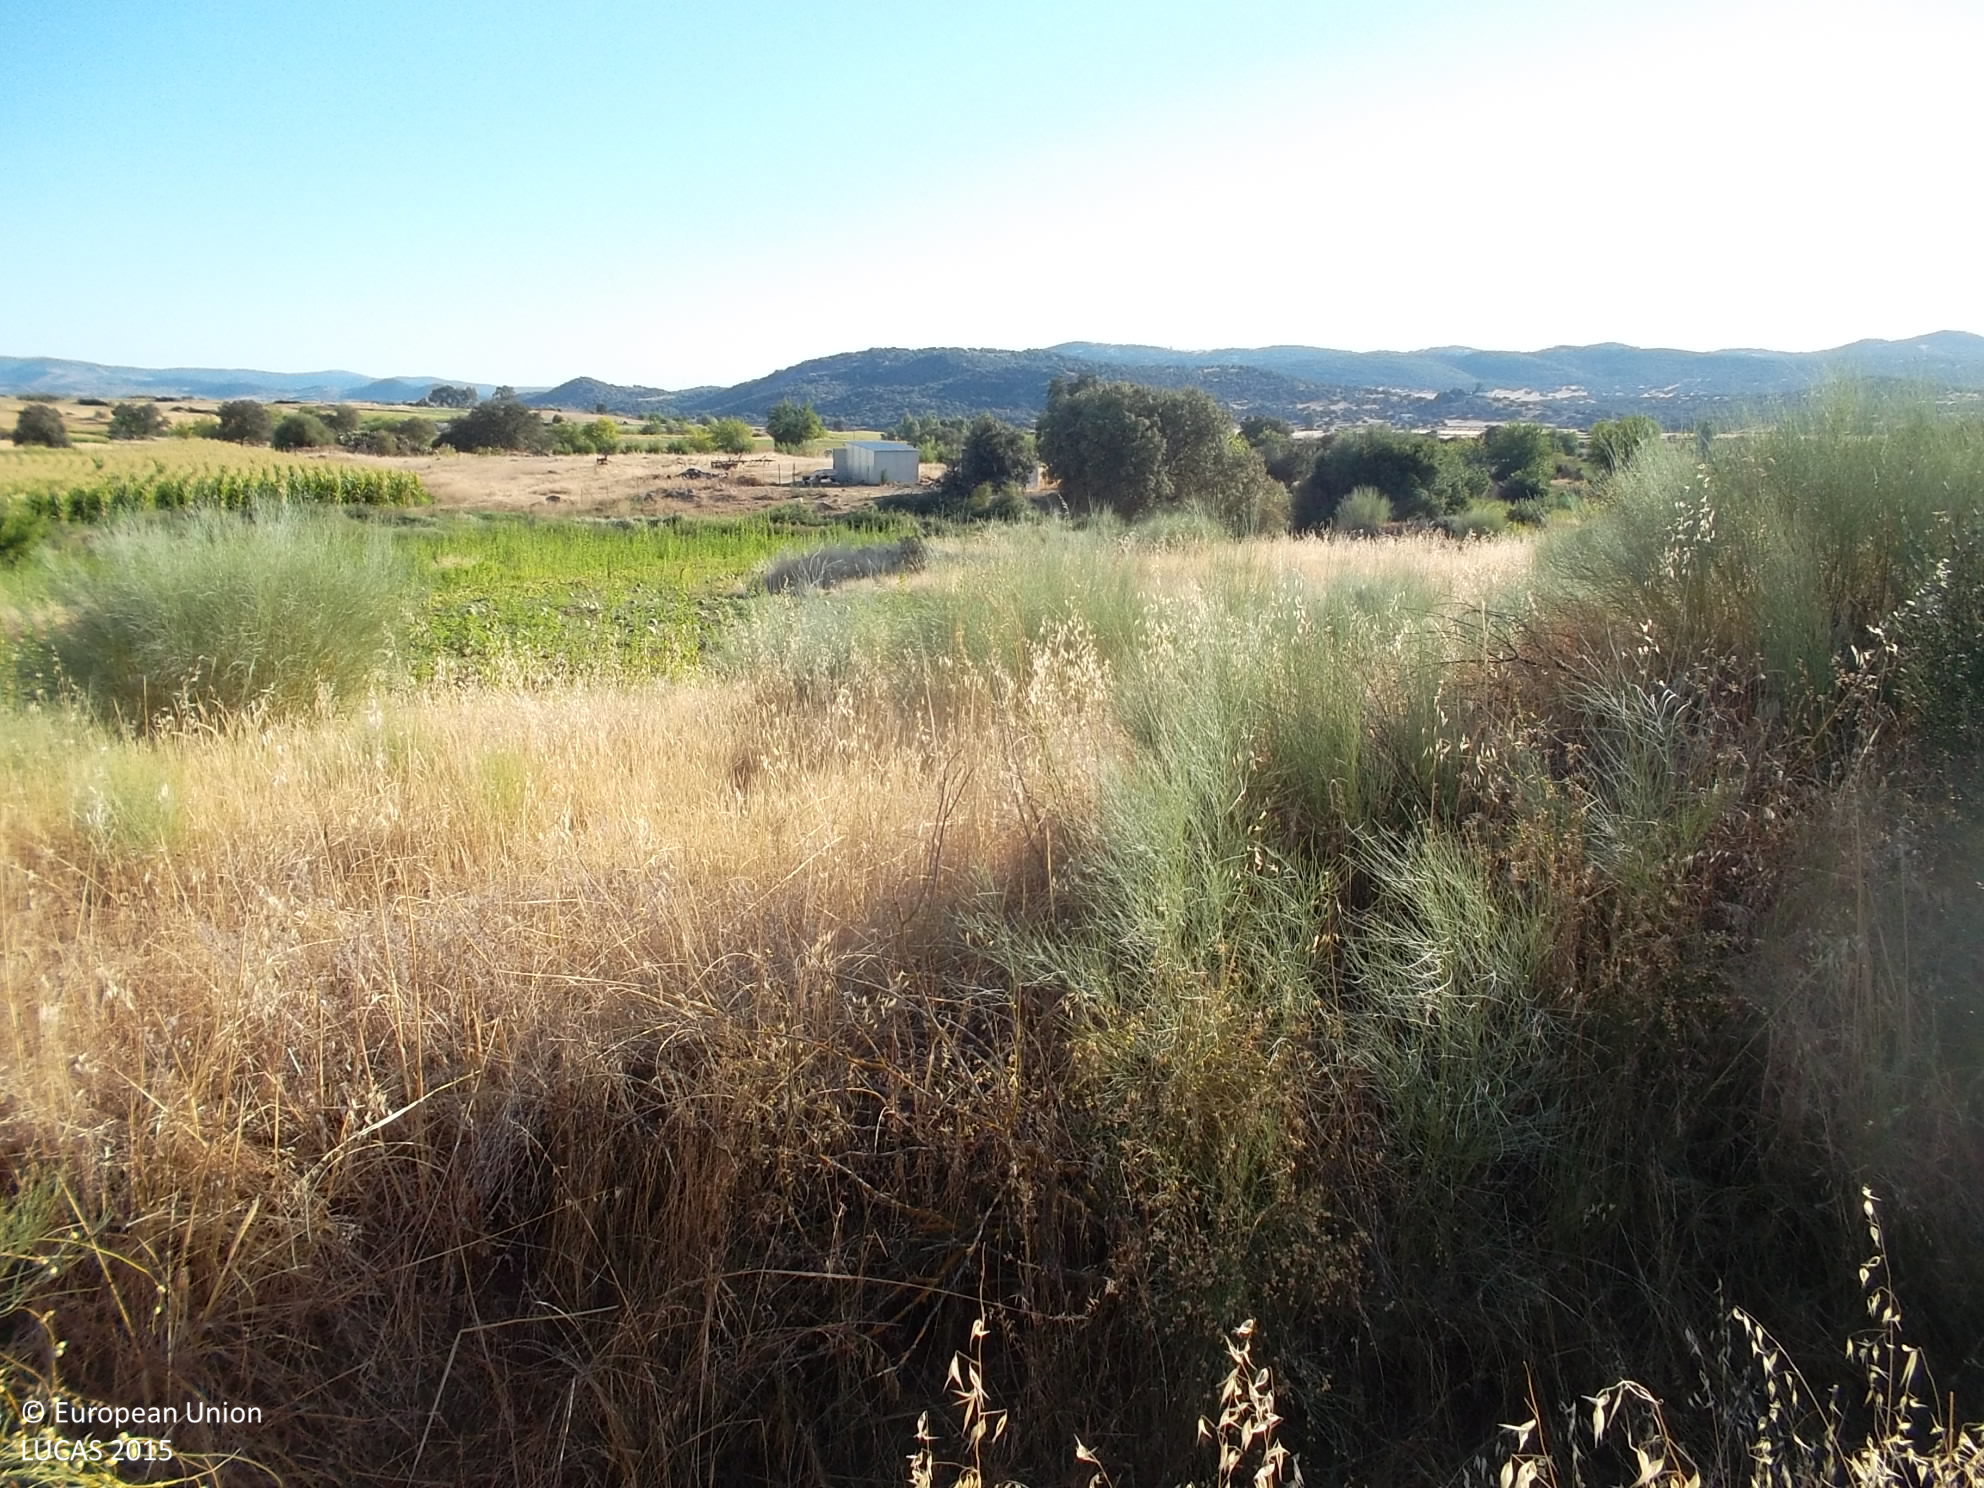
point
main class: Shrubland
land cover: Shrubland with sparse tree cover
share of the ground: > 75 %
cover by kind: herbaceous plants 75 %, shrubs 20 %, broadleaved forest trees 5 %
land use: Agriculture (excluding fallow land and kitchen gardens)
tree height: < 5 m
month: August
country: ES
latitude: 38.3663
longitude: -6.6844
